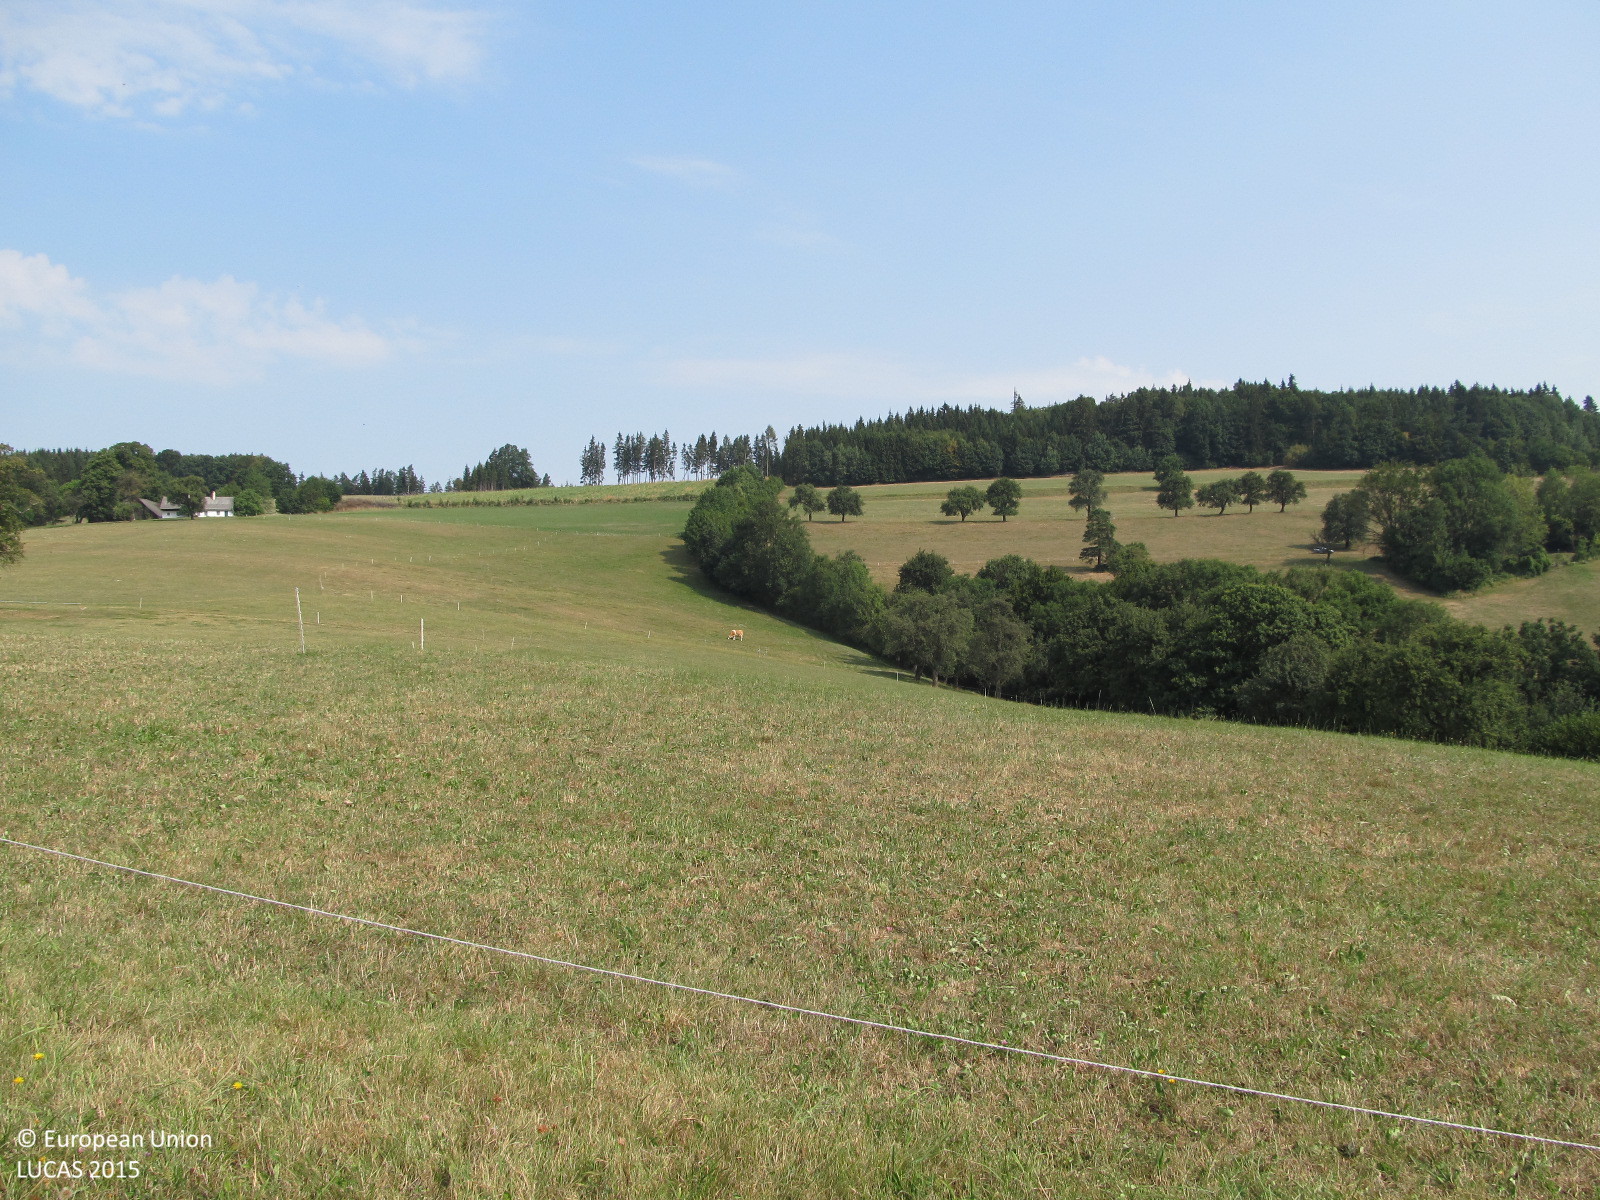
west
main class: Grassland
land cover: Grassland without tree/shrub cover
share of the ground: > 75 %
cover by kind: herbaceous plants 100 %
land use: Agriculture (excluding fallow land and kitchen gardens)
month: August
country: AT
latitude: 48.0826
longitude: 15.5732
